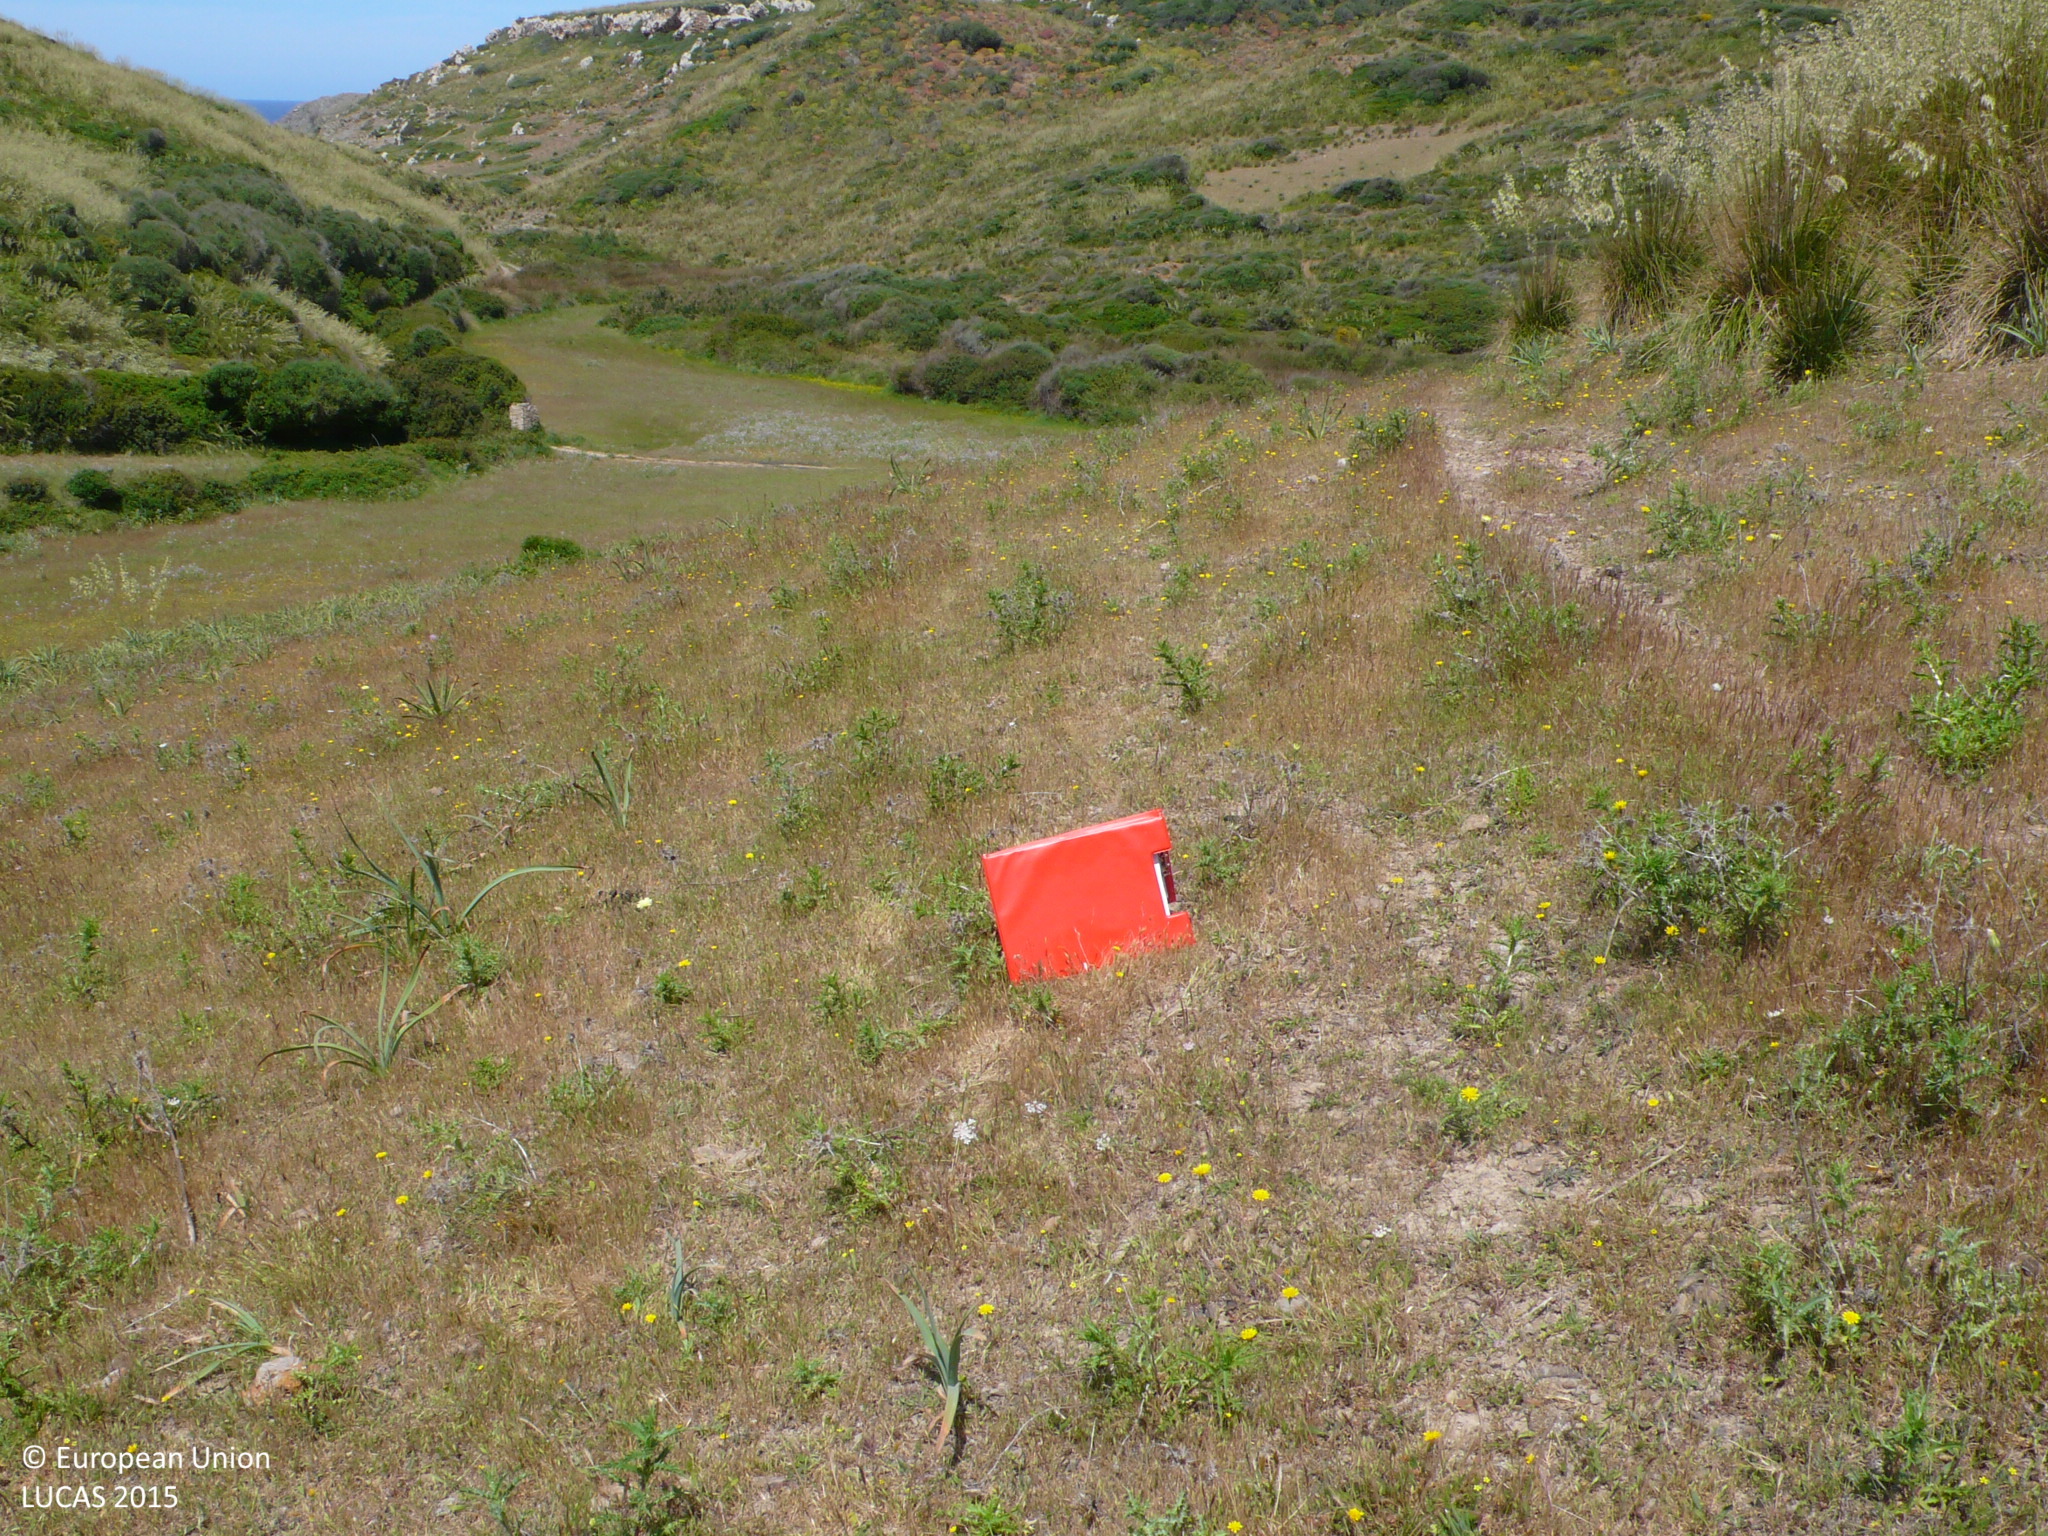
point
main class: Grassland
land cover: Grassland without tree/shrub cover
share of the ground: > 75 %
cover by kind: herbaceous plants 95 %, shrubs 5 %
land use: Agriculture (excluding fallow land and kitchen gardens)
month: May
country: ES
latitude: 39.9885
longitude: 4.2285
